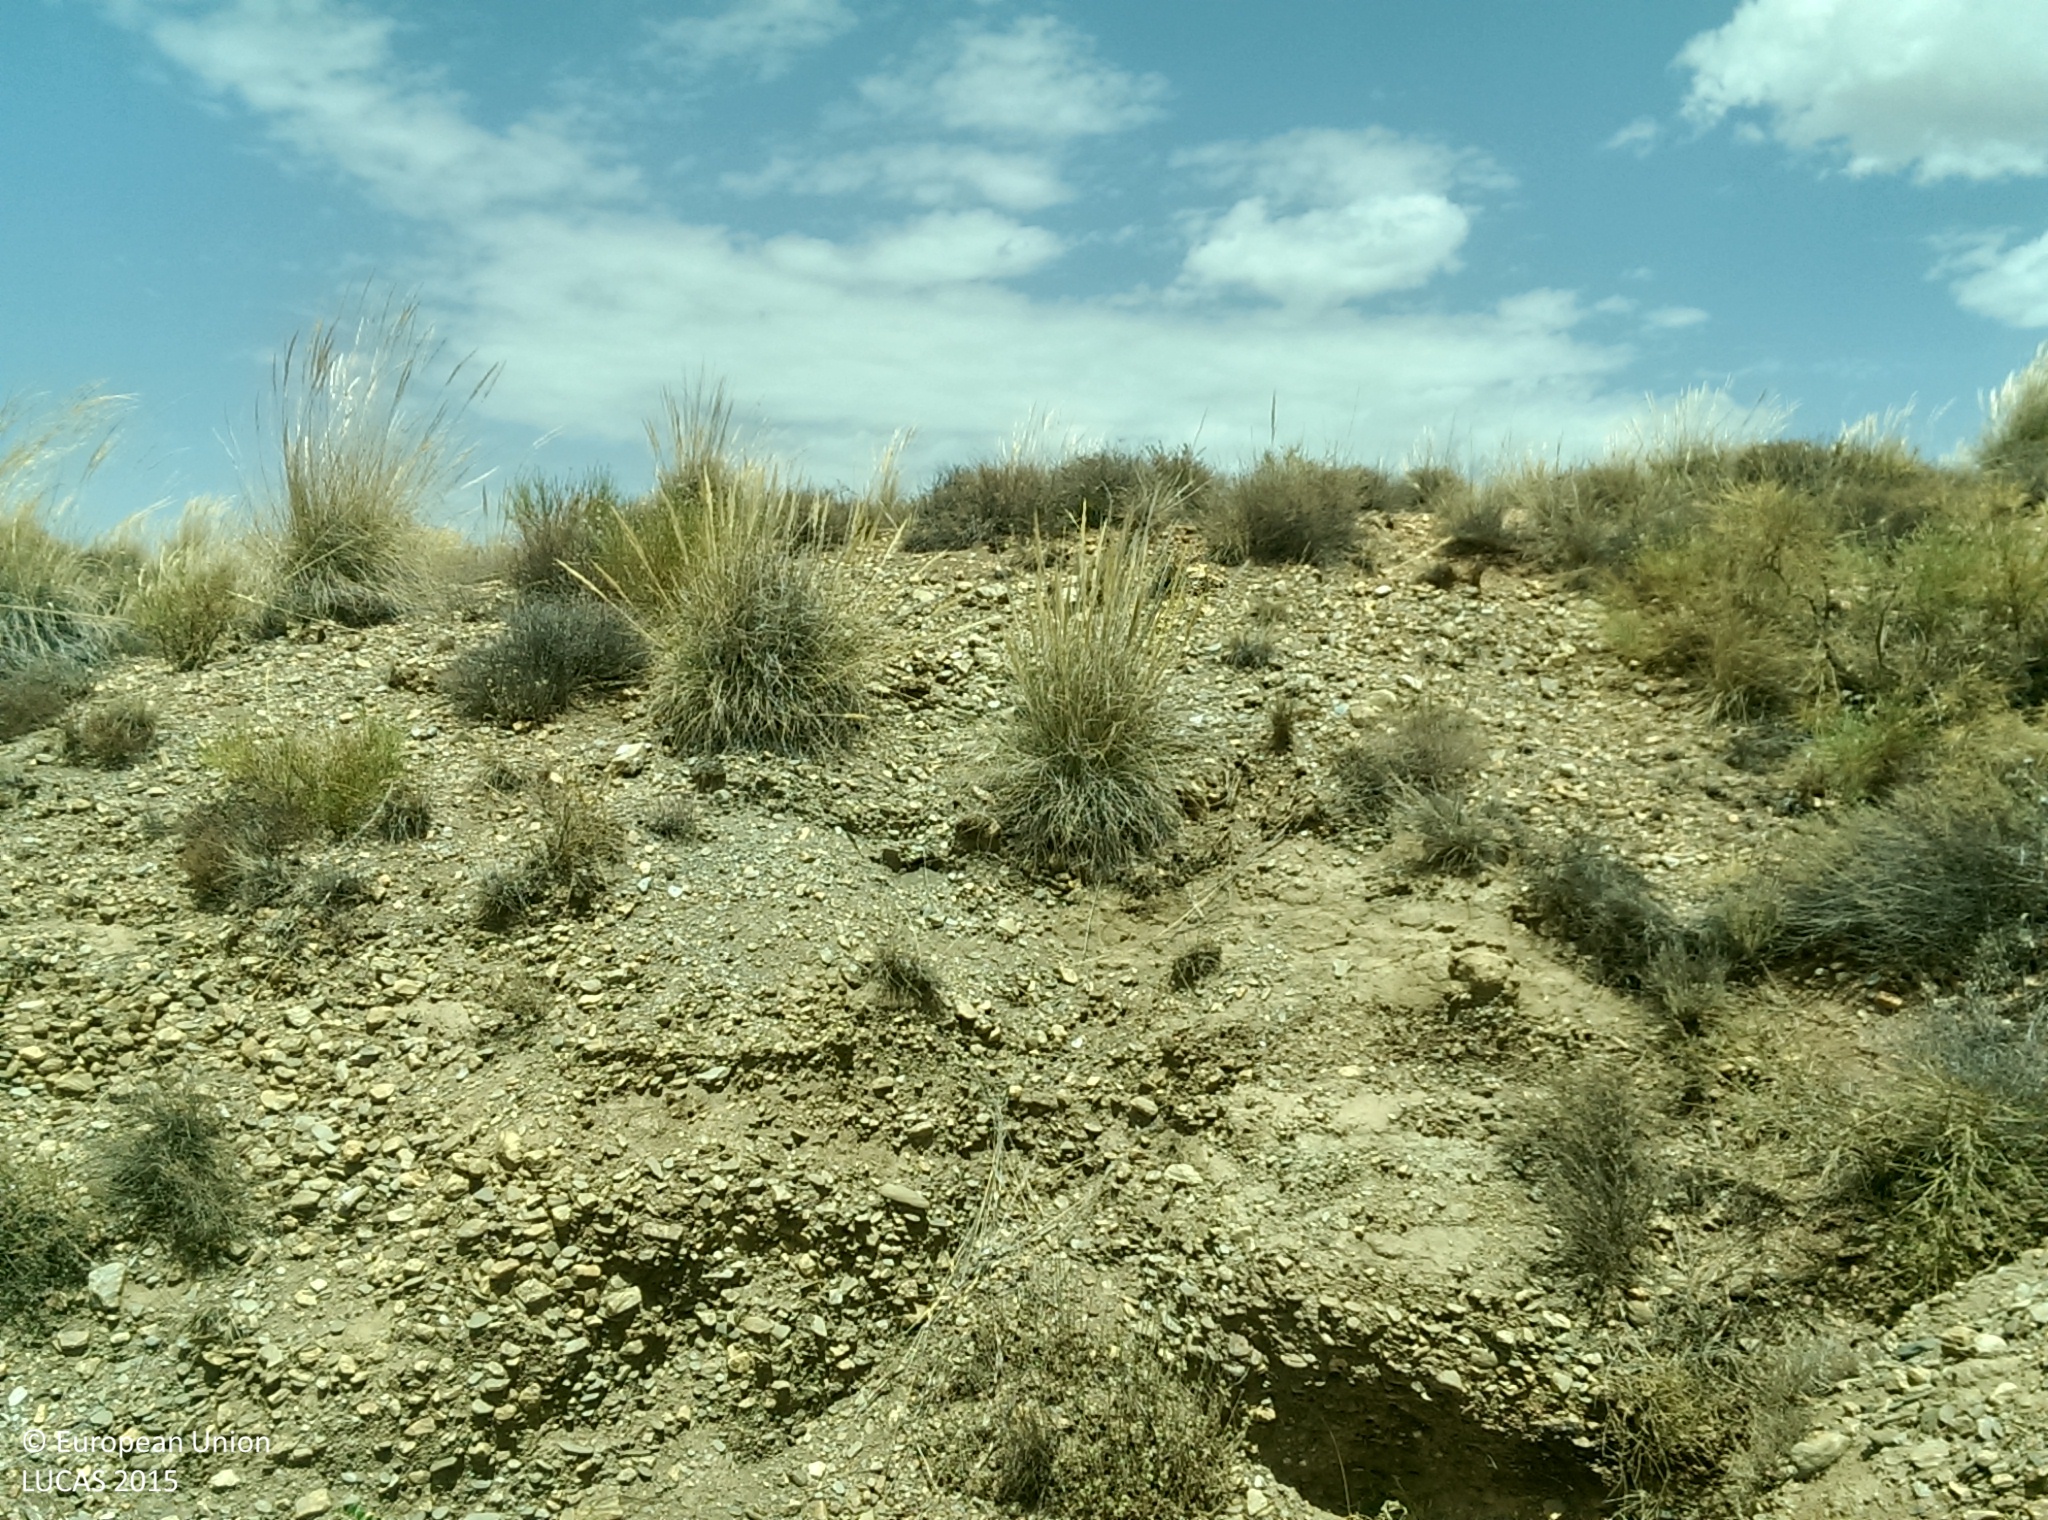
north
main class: Shrubland
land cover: Shrubland without tree cover
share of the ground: 25 - 50 %
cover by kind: shrubs 45 %, unconsolidated bare surface 35 %, herbaceous plants 20 %
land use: Semi-natural and natural areas not in use
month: July
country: ES
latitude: 37.2234
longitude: -3.0926
